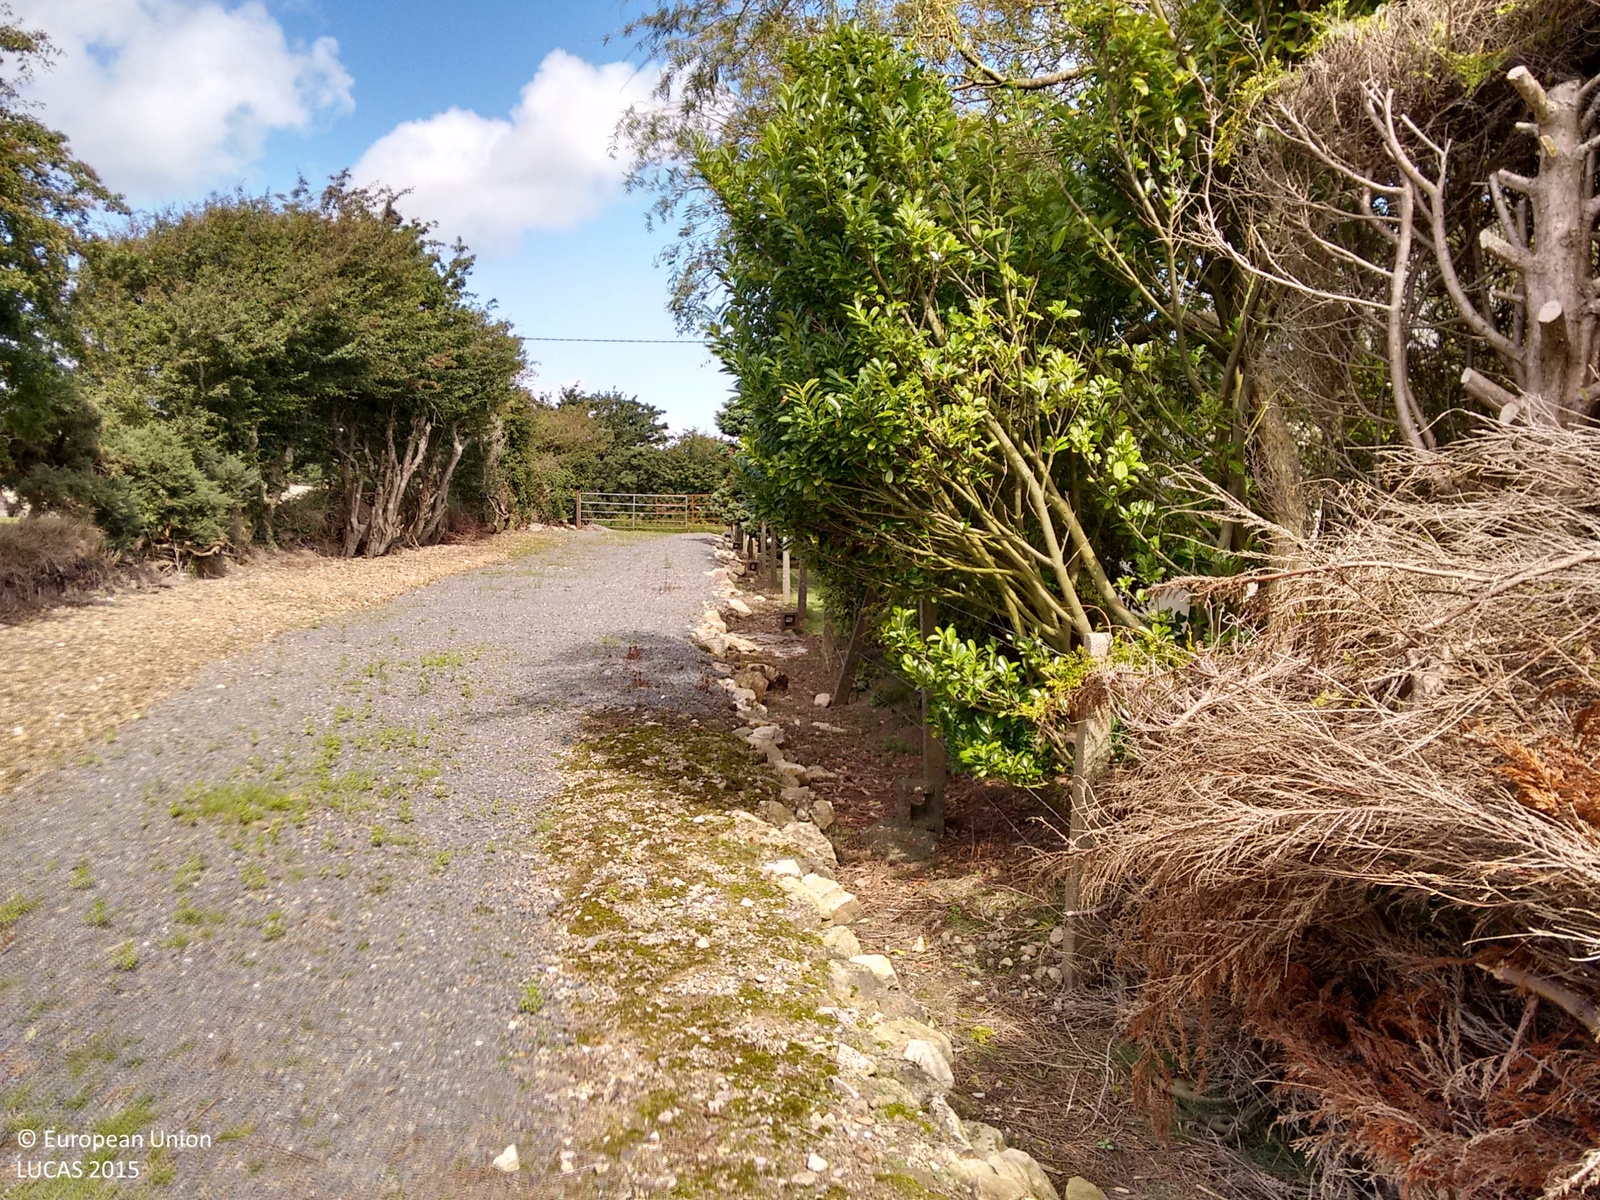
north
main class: Grassland
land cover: Grassland with sparse tree/shrub cover
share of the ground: > 75 %
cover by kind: herbaceous plants 95 %, broadleaved forest trees 5 %
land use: Residential
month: August
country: IE
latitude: 52.2903
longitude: -6.5346
